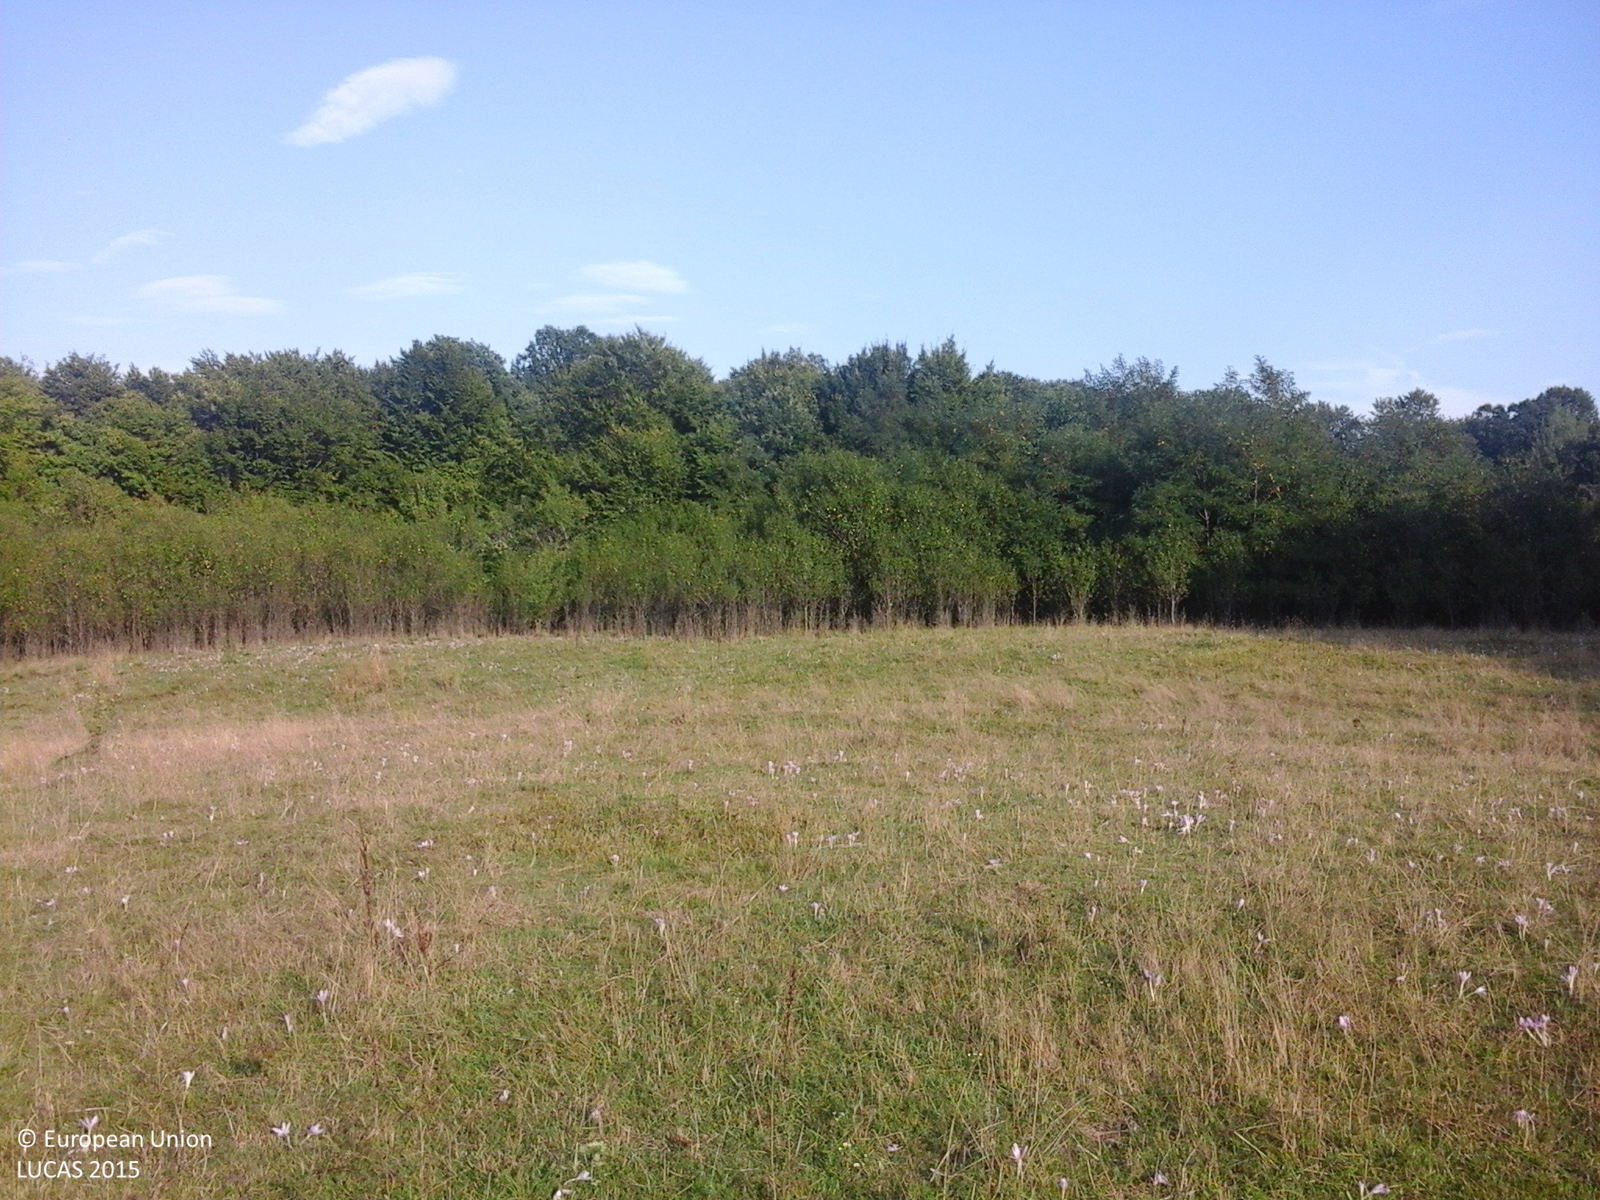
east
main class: Grassland
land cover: Grassland without tree/shrub cover
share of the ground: > 75 %
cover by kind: herbaceous plants 100 %
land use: Agriculture (excluding fallow land and kitchen gardens)
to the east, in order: Grassland without tree/shrub cover; Broadleaved woodland; Ditches and canals; Broadleaved woodland
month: September
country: RO
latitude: 45.7732
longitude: 22.8480
